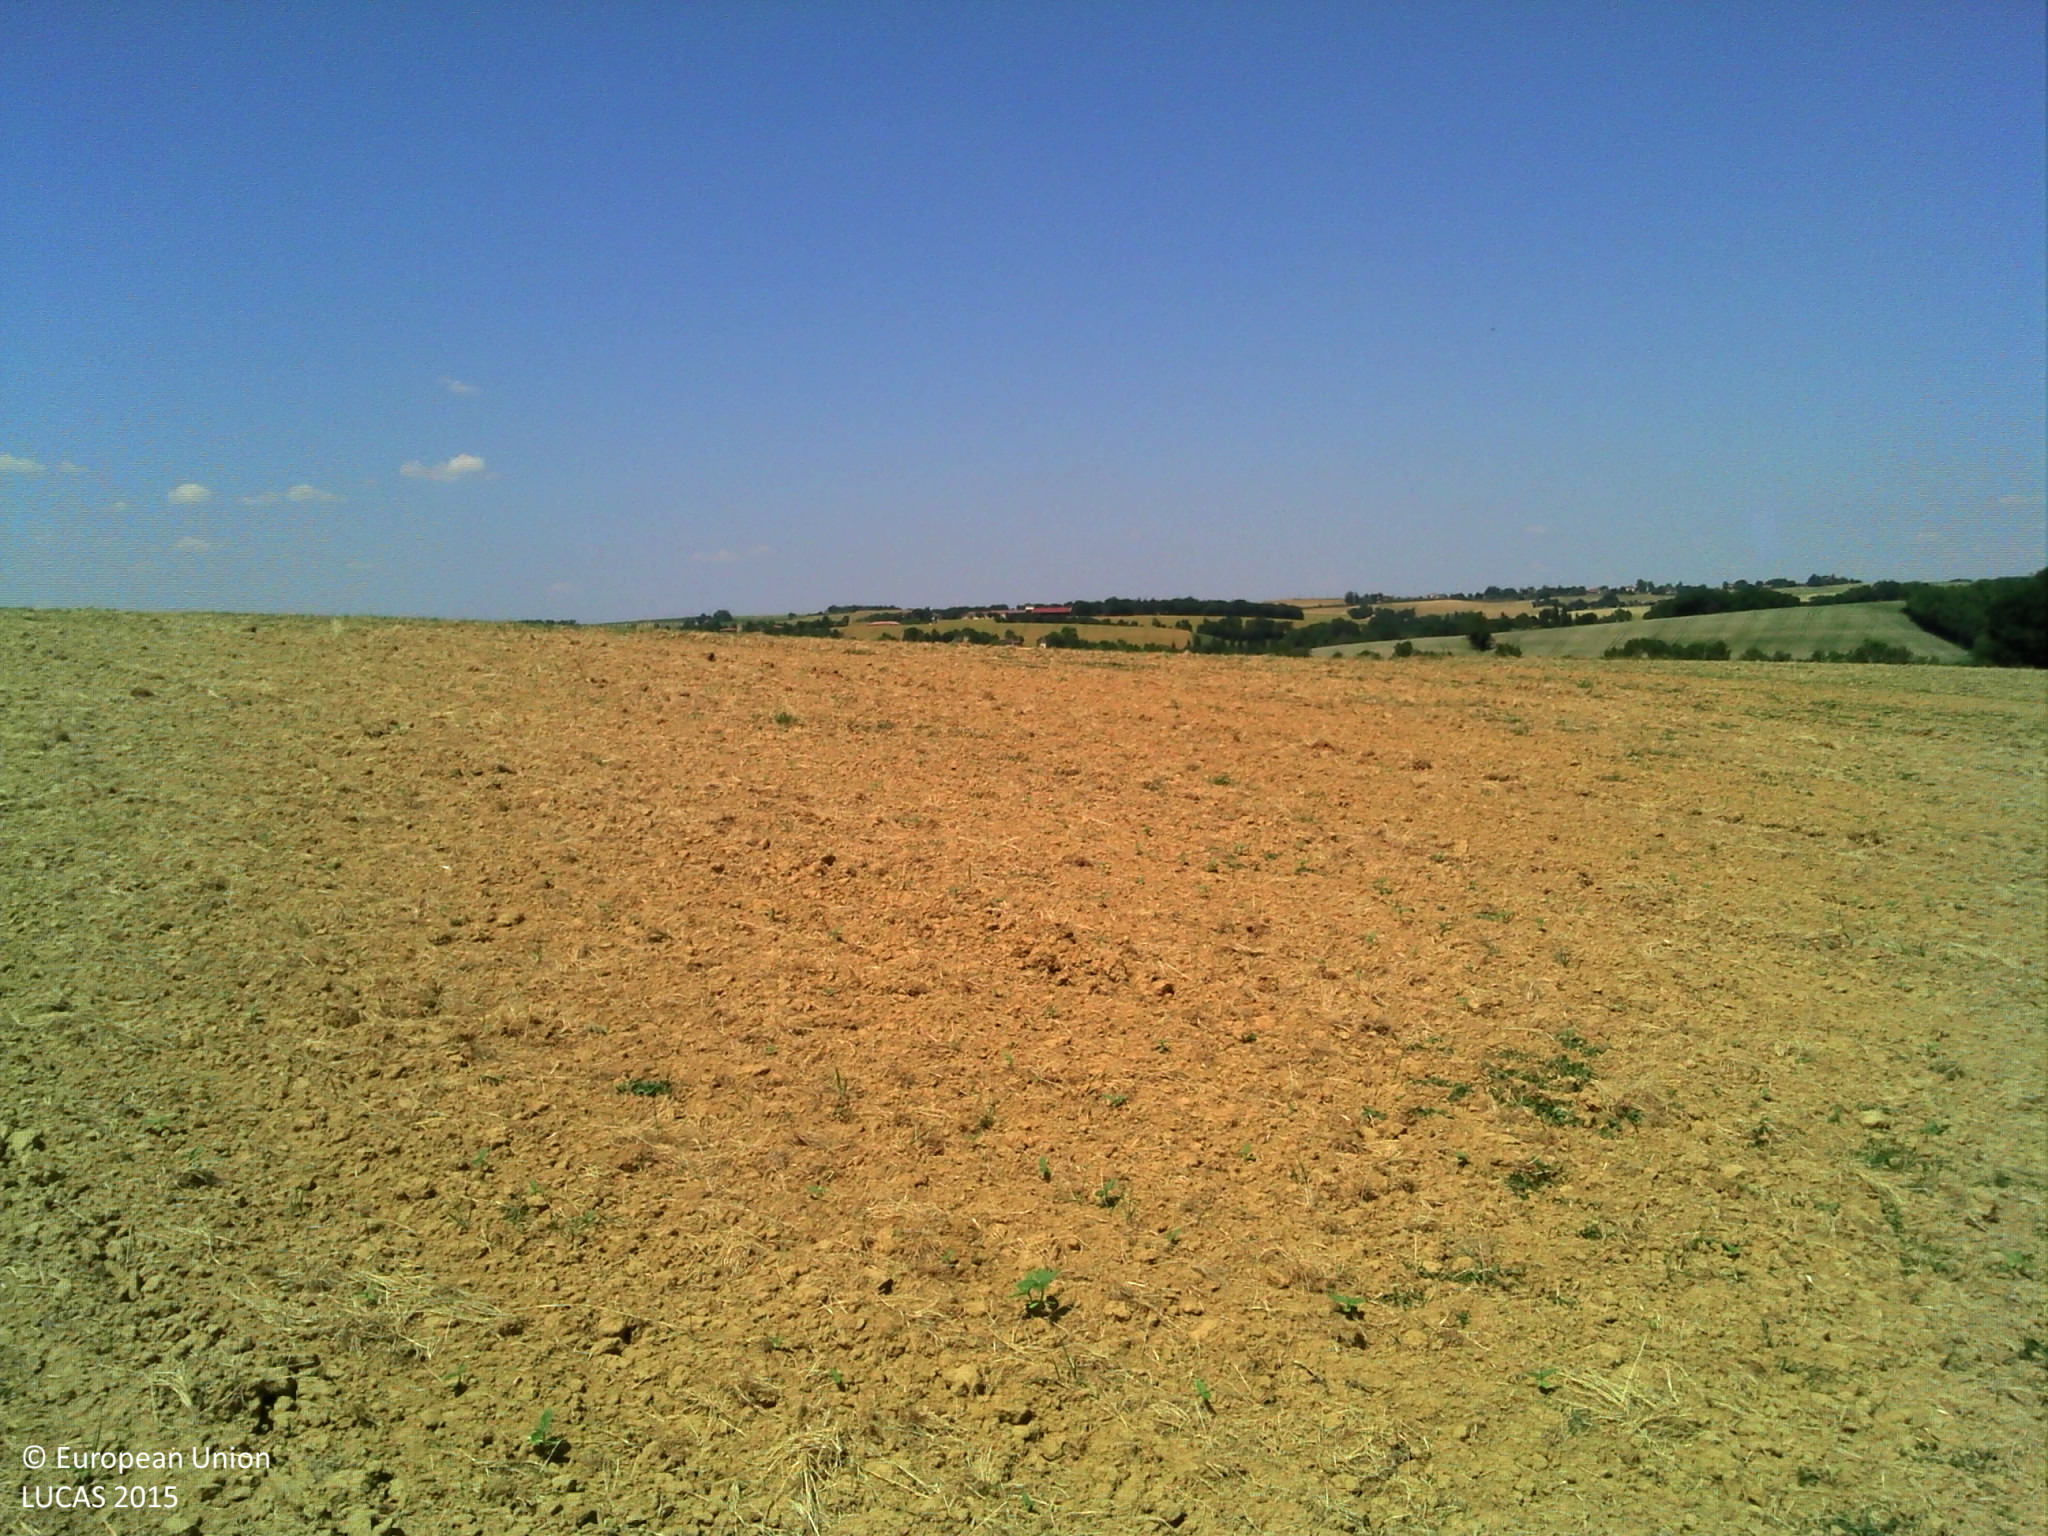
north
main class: Cropland
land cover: Sunflower
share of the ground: < 10 %
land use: Agriculture (excluding fallow land and kitchen gardens)
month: June
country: FR
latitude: 43.7302
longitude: 0.6743
